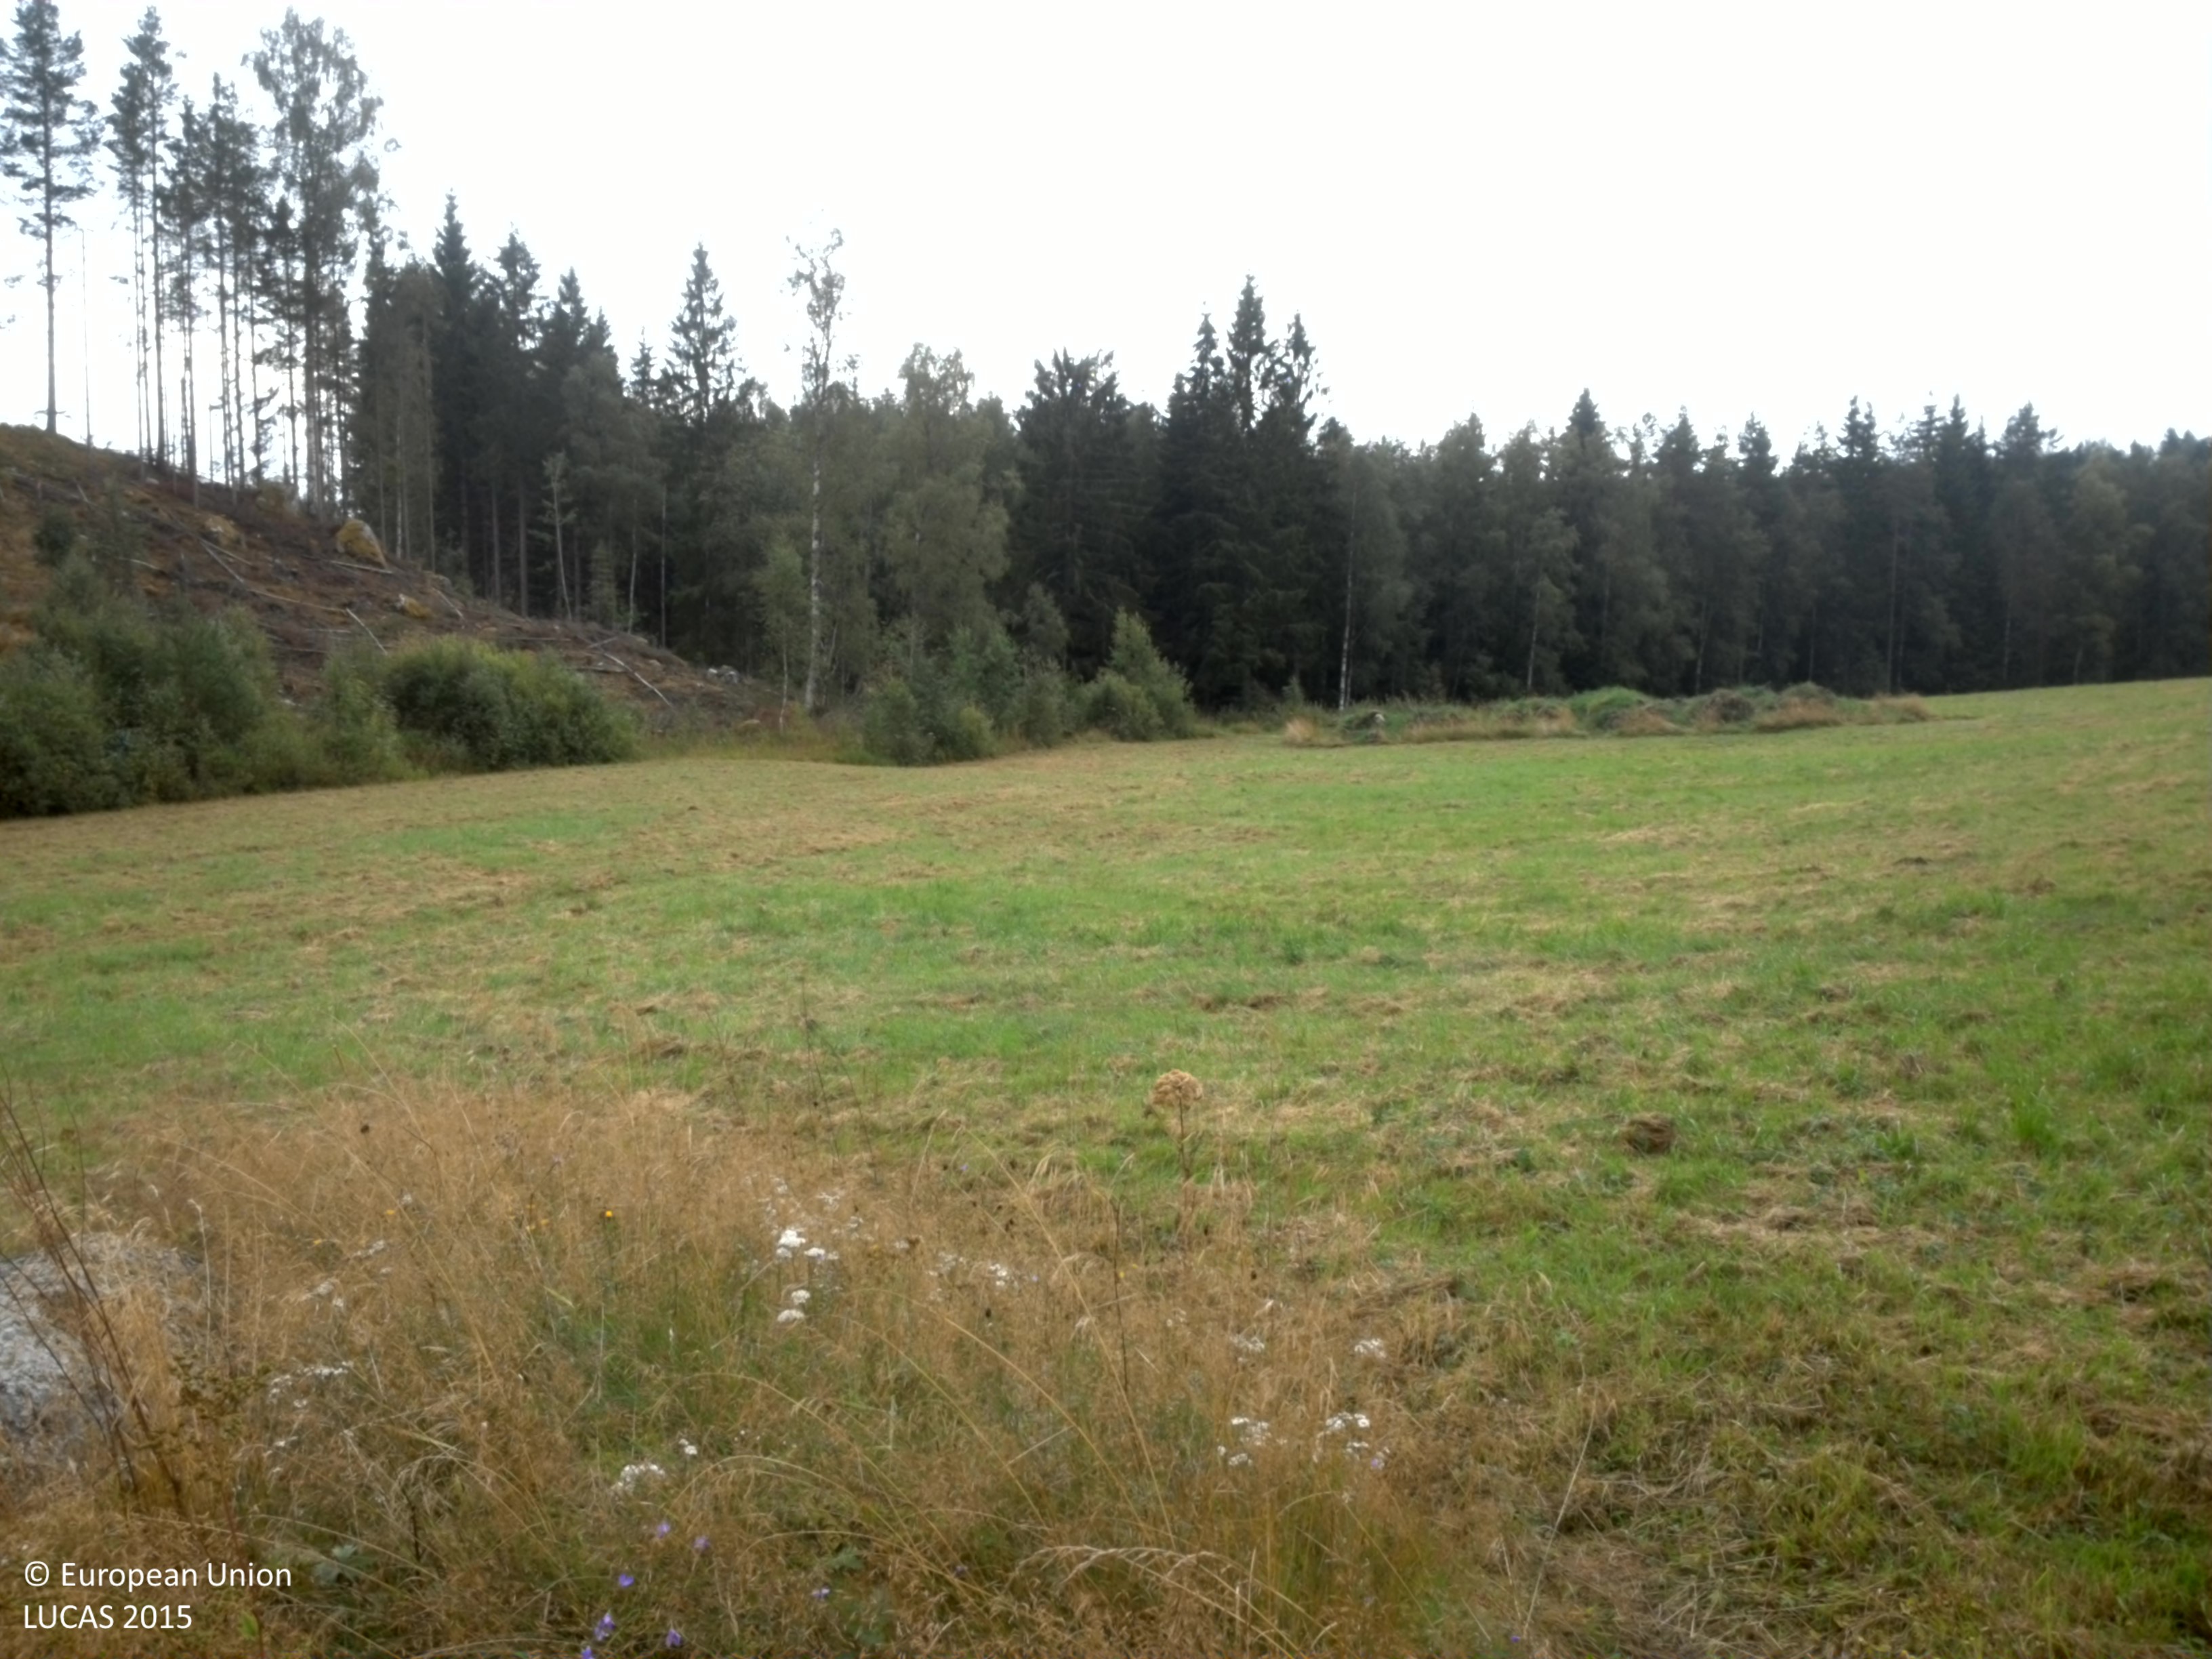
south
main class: Grassland
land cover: Grassland without tree/shrub cover
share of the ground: > 75 %
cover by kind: herbaceous plants 100 %
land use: Agriculture (excluding fallow land and kitchen gardens)
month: August
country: SE
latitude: 59.7807
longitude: 15.6012
